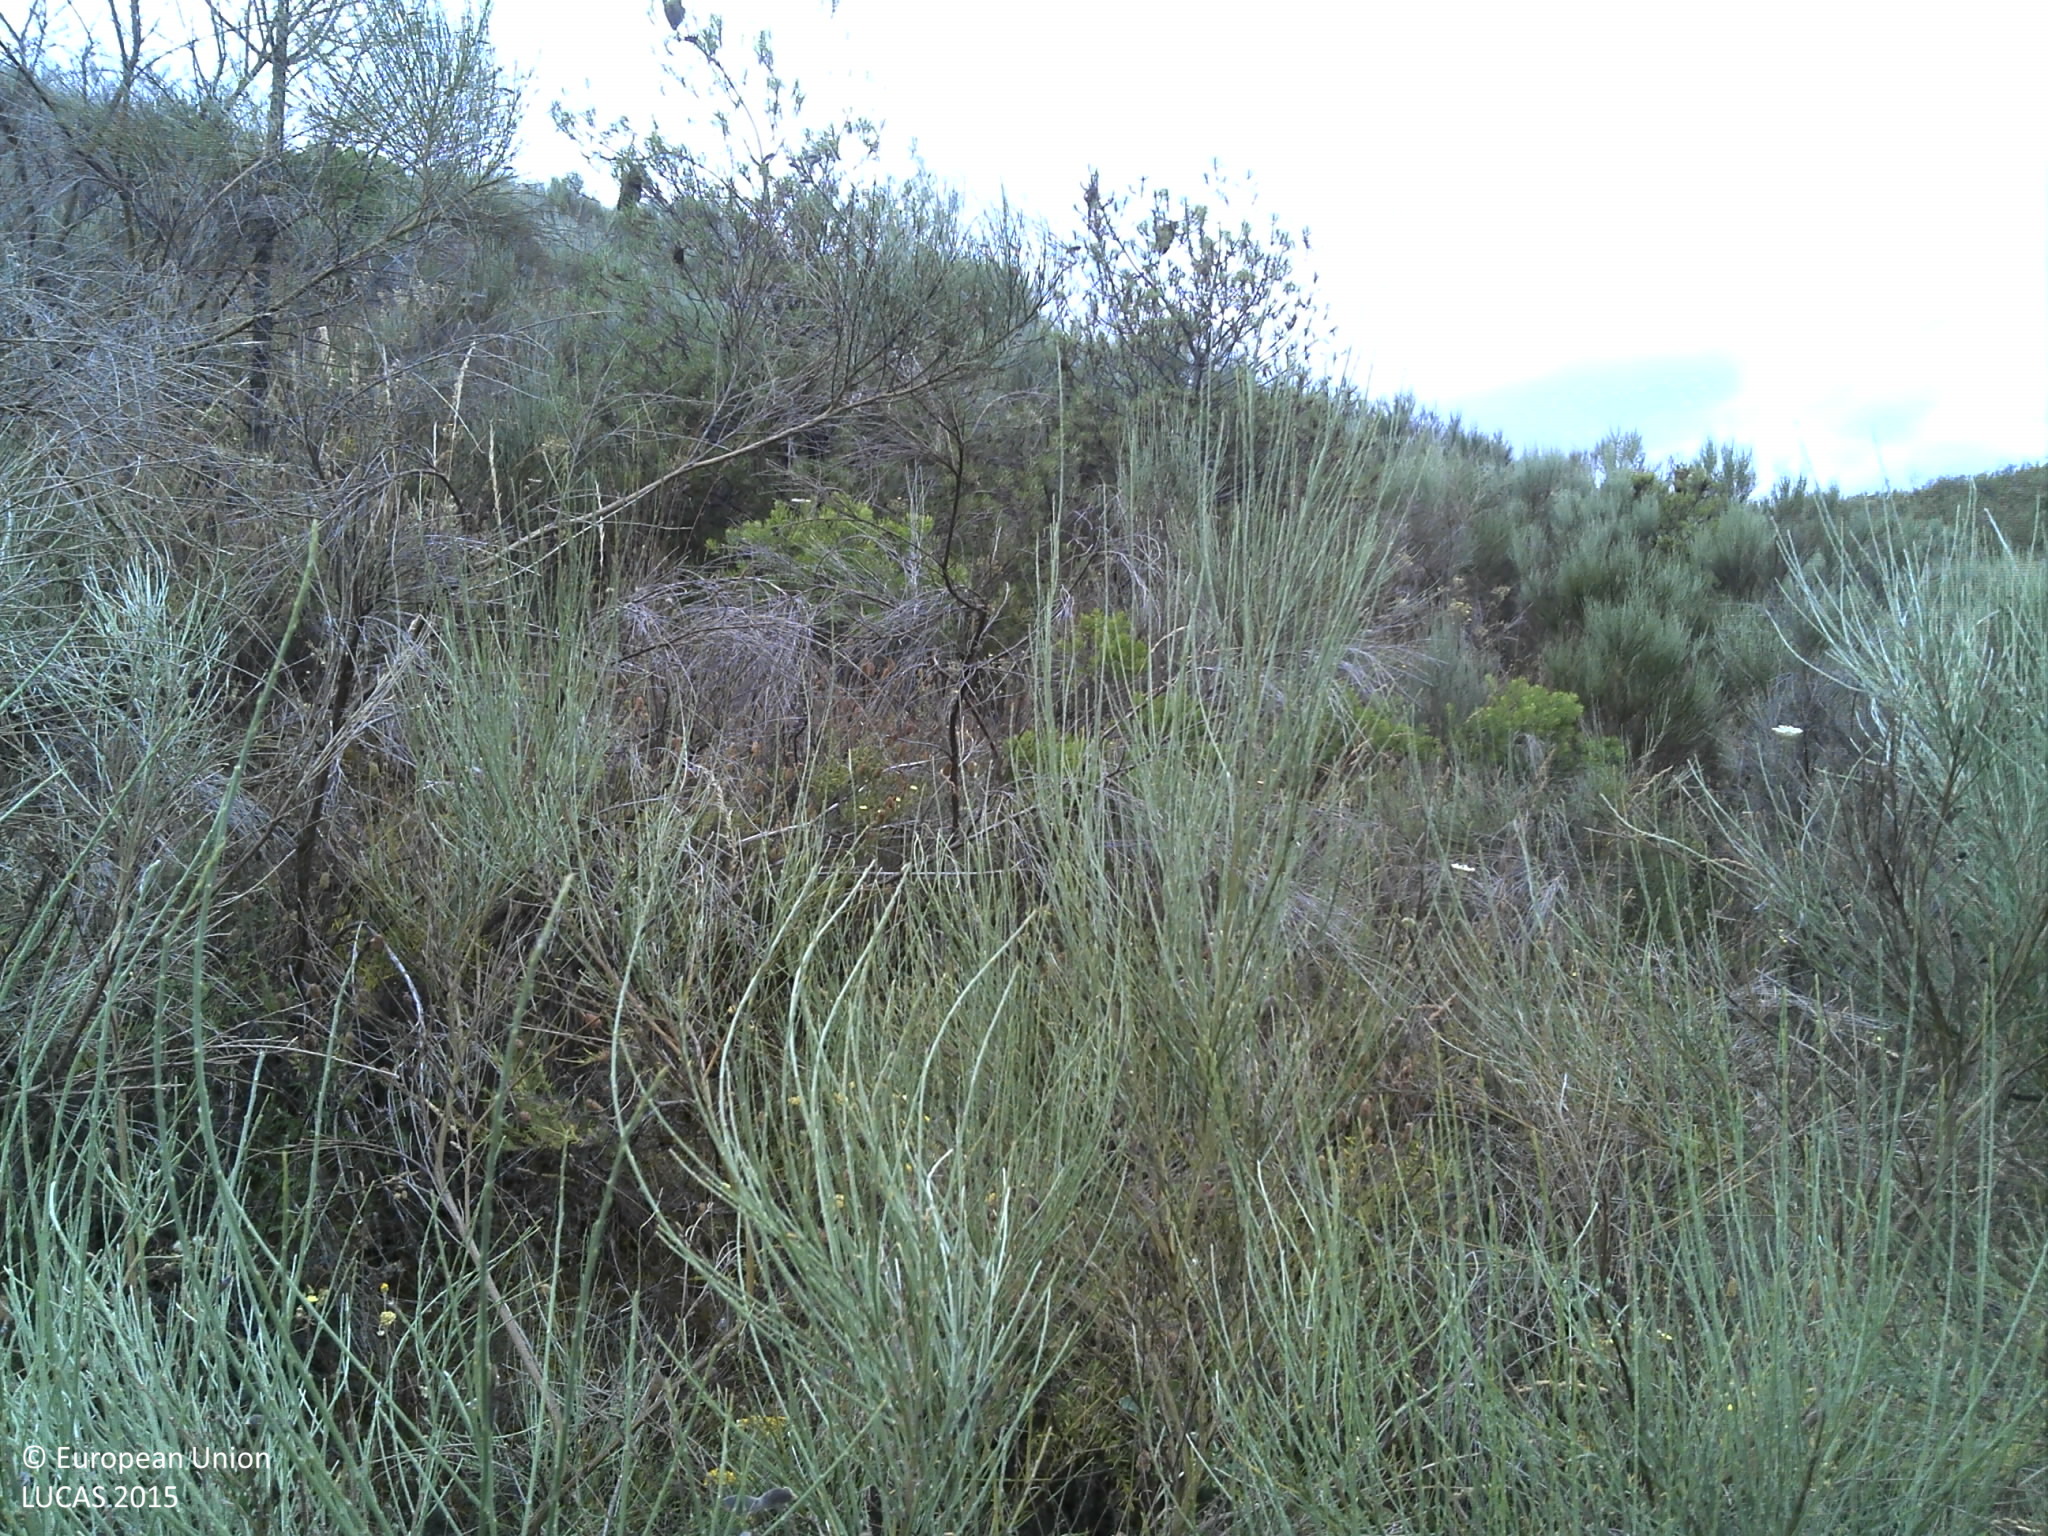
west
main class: Shrubland
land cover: Shrubland with sparse tree cover
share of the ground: > 75 %
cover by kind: shrubs 95 %, coniferous forest trees 5 %
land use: Abandoned areas
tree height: < 5 m
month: June
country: PT
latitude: 41.2855
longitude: -6.9578
